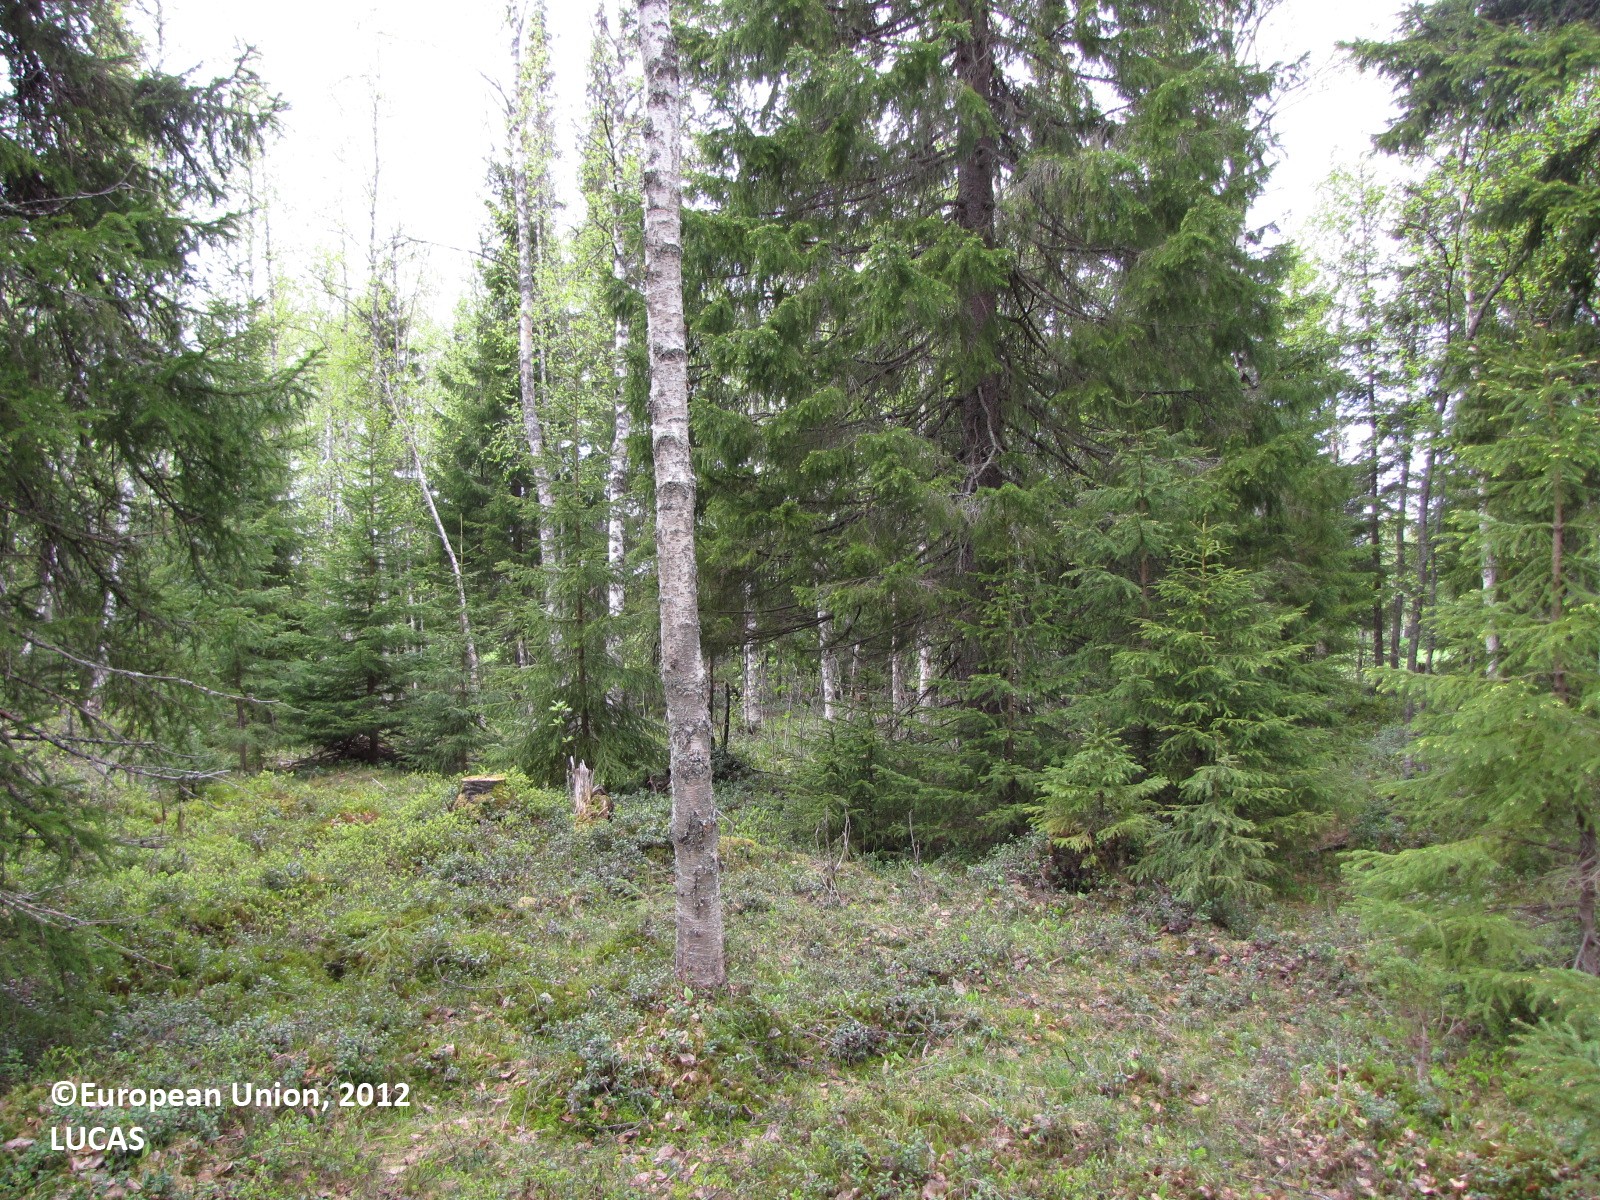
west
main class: Woodland
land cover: Spruce dominated mixed woodland
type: boreal forest
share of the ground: 50 - 75 %
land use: Forestry
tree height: > 5 m
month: June
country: FI
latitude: 65.8990
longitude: 24.5602
